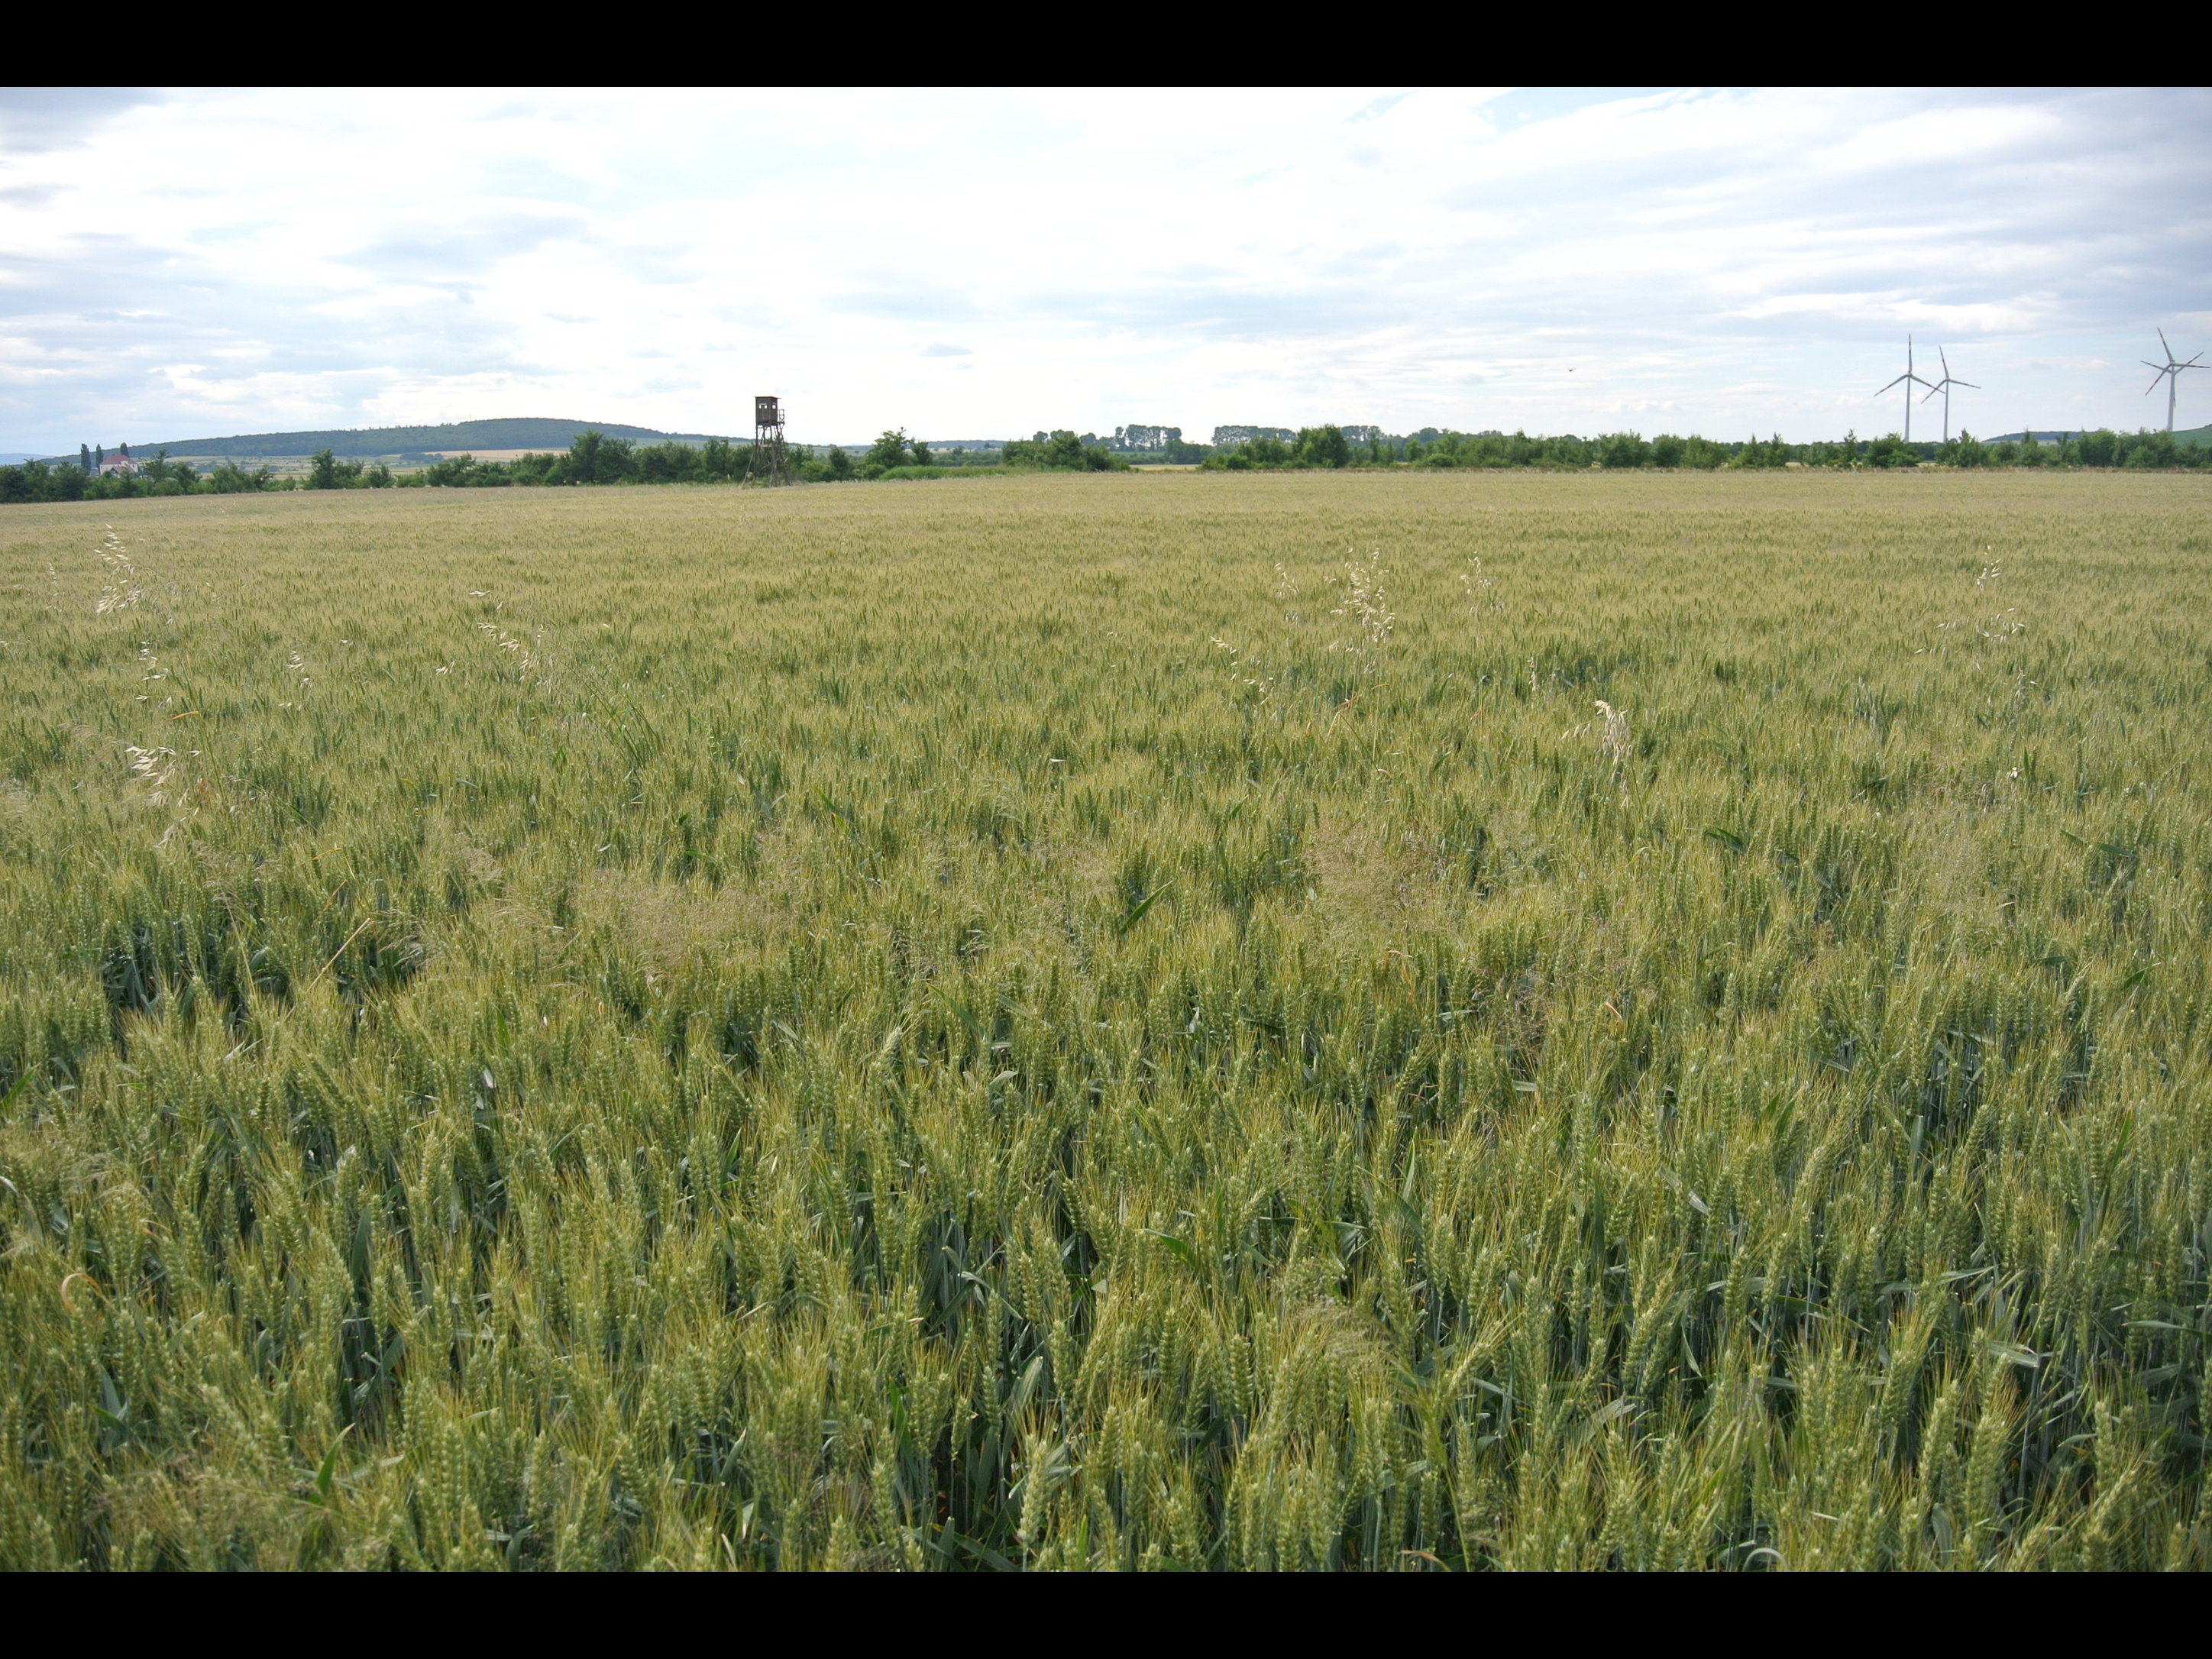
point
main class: Cropland
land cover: Common wheat
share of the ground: > 75 %
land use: Agriculture (excluding fallow land and kitchen gardens)
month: June
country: AT
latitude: 47.7218
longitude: 16.5502
